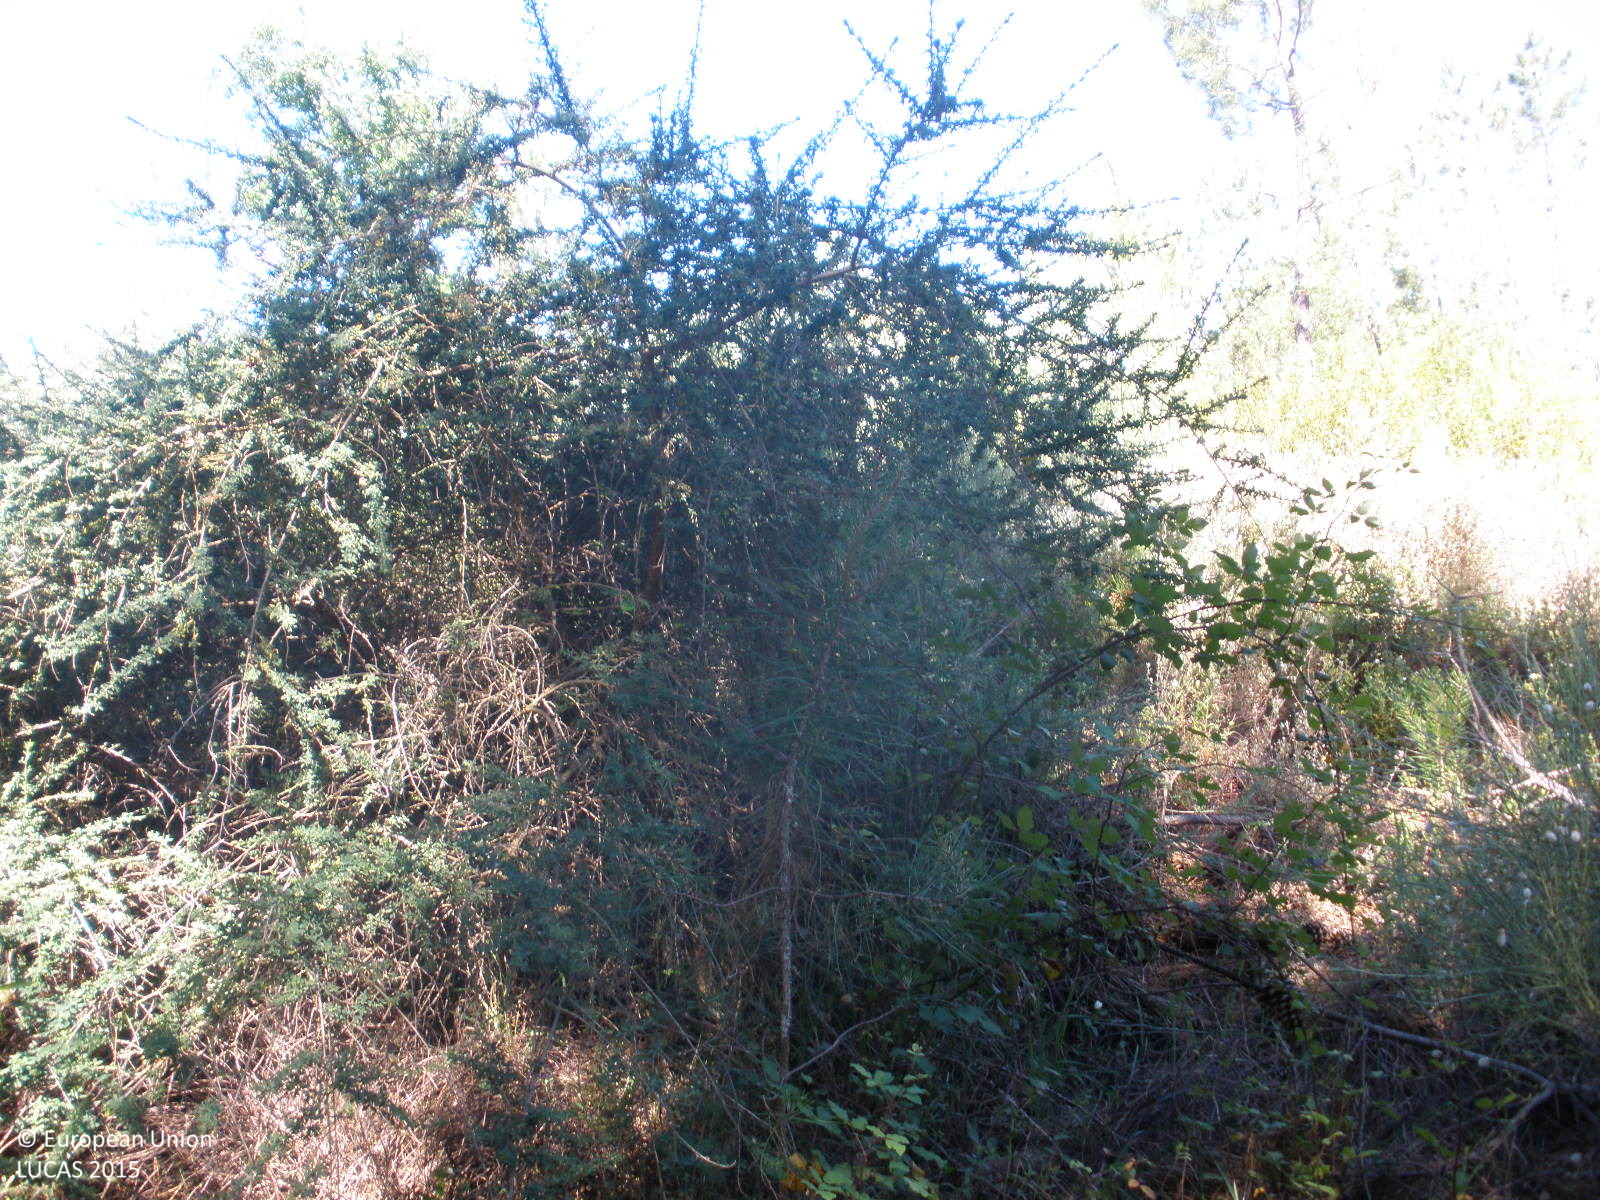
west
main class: Woodland
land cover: Pine dominated coniferous woodland
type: coniferous forest of the mediterranean region
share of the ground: > 75 %
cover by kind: coniferous forest trees 90 %, shrubs 10 %
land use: Forestry
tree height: > 5 m
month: May
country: ES
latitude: 40.2106
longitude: -6.5688
